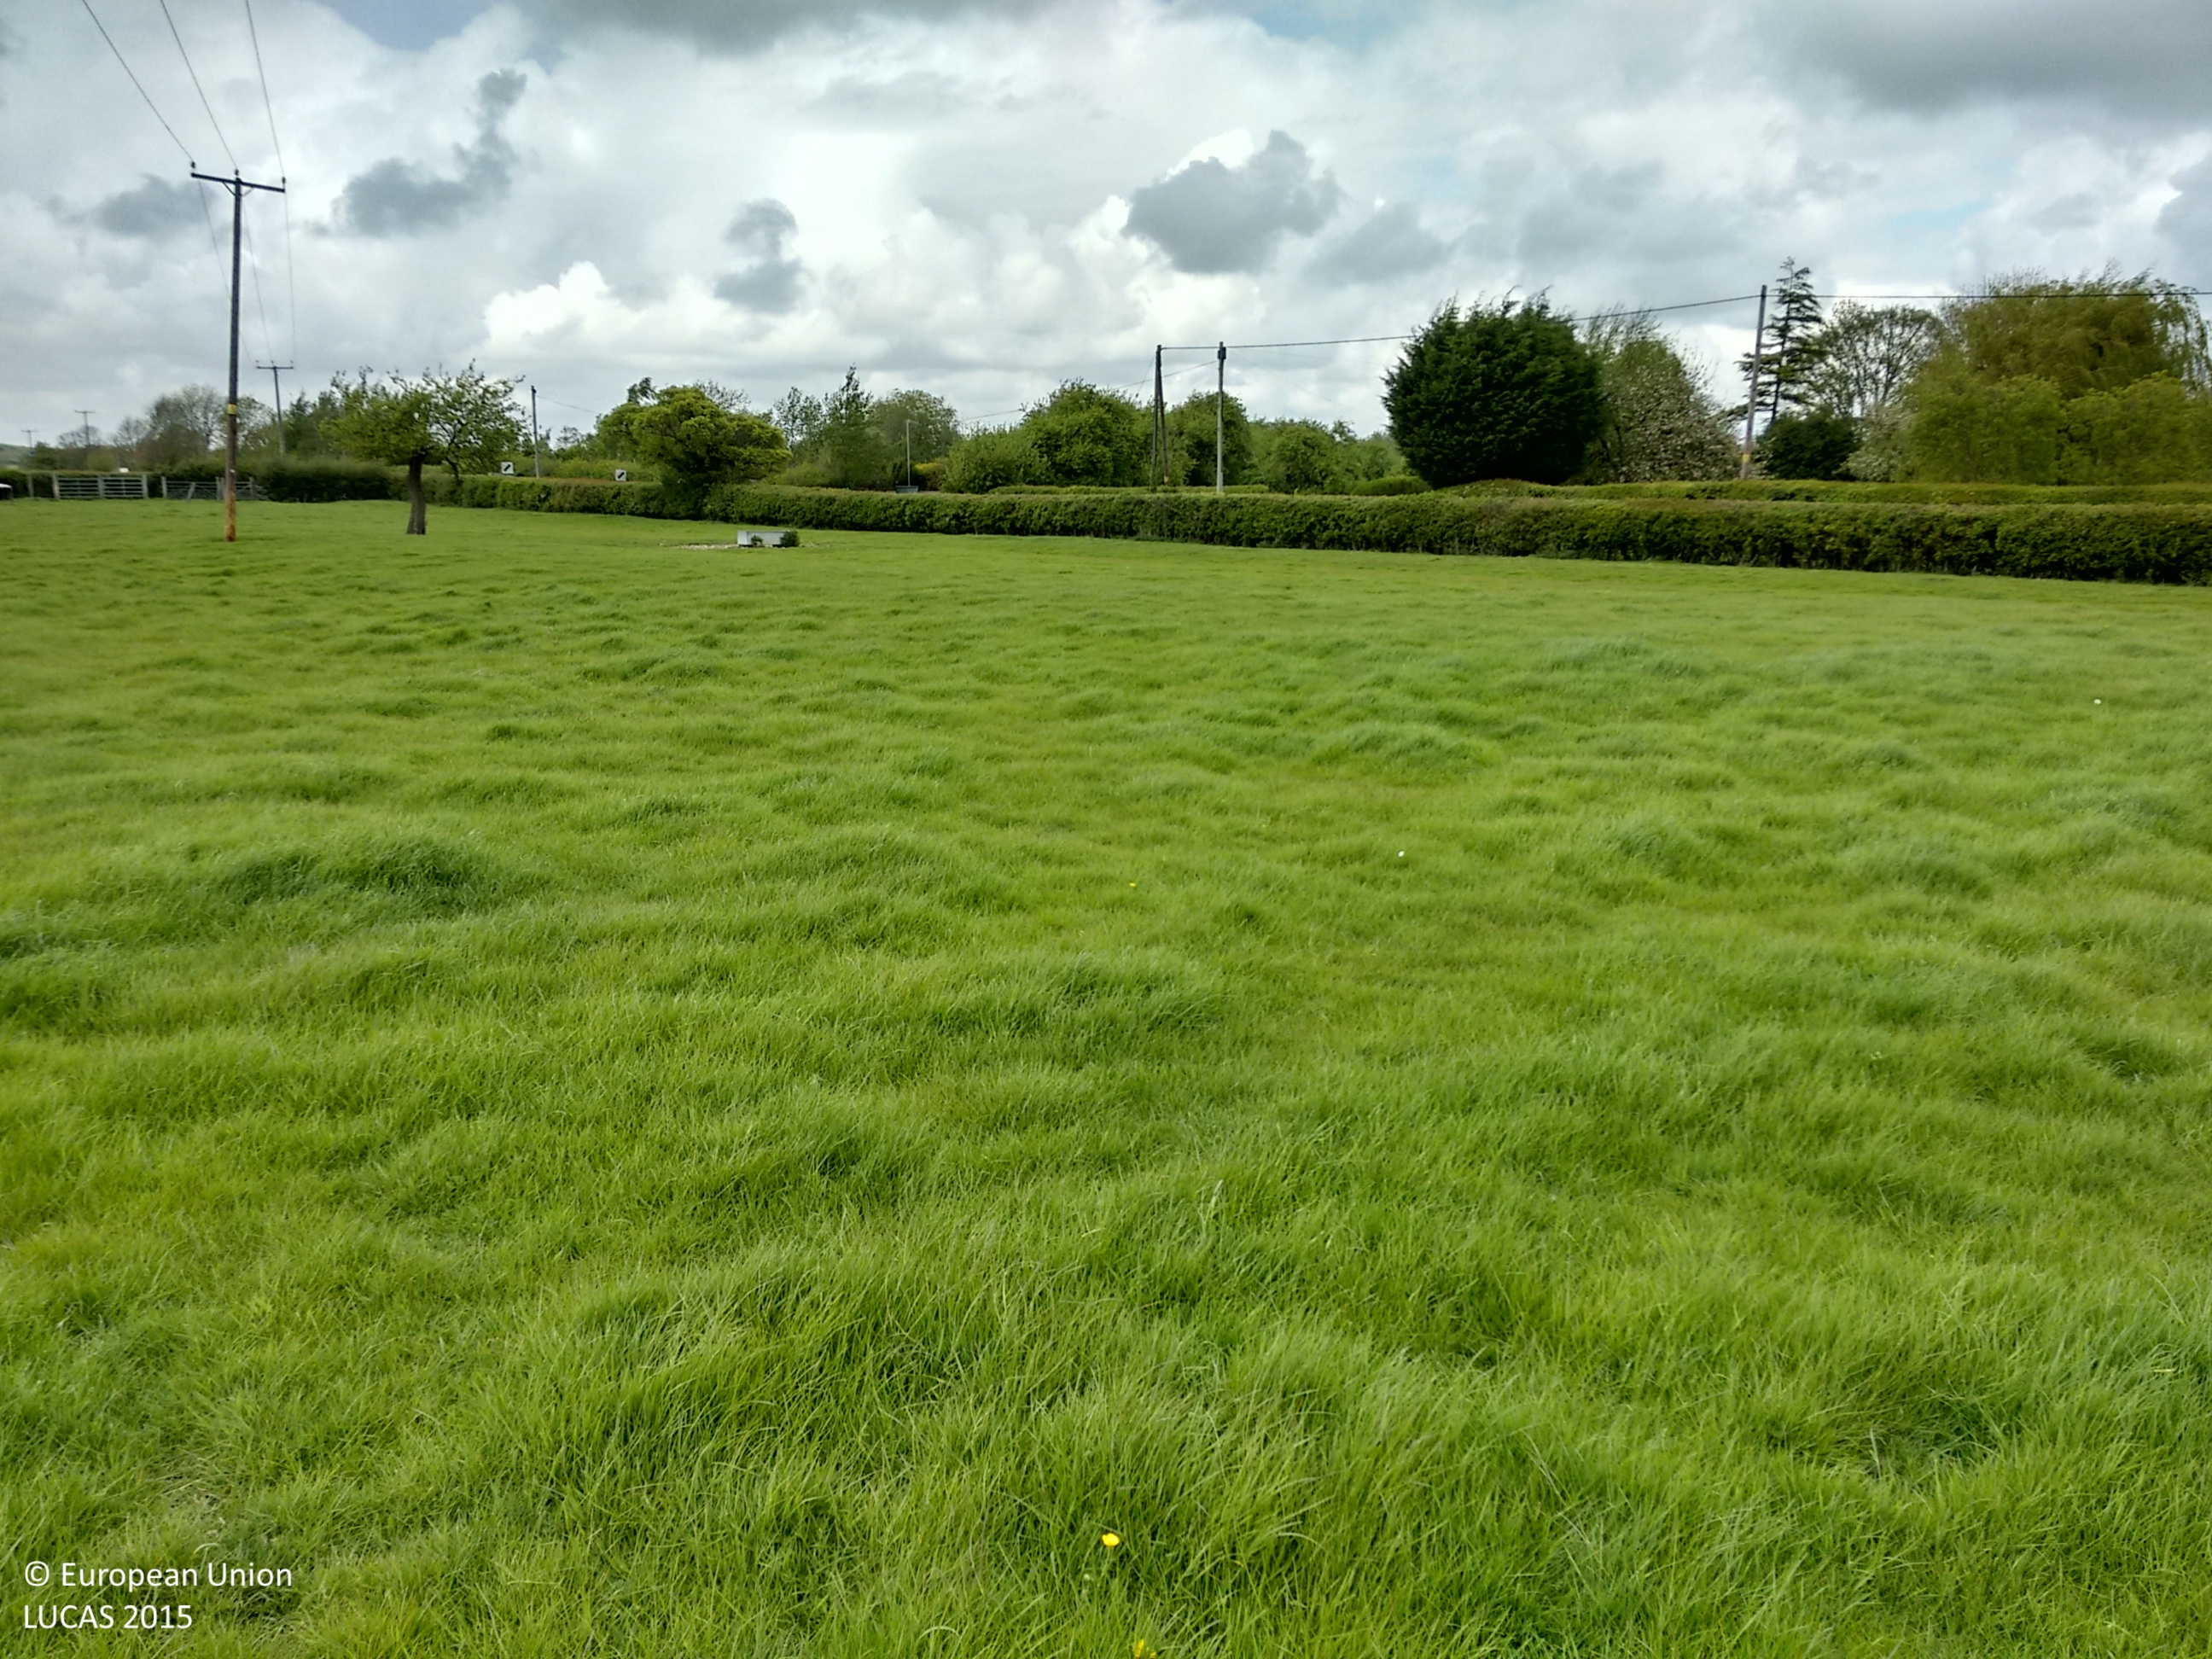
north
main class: Grassland
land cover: Grassland without tree/shrub cover
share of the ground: > 75 %
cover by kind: herbaceous plants 100 %
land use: Agriculture (excluding fallow land and kitchen gardens)
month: May
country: GB
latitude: 51.8832
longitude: -0.6013
